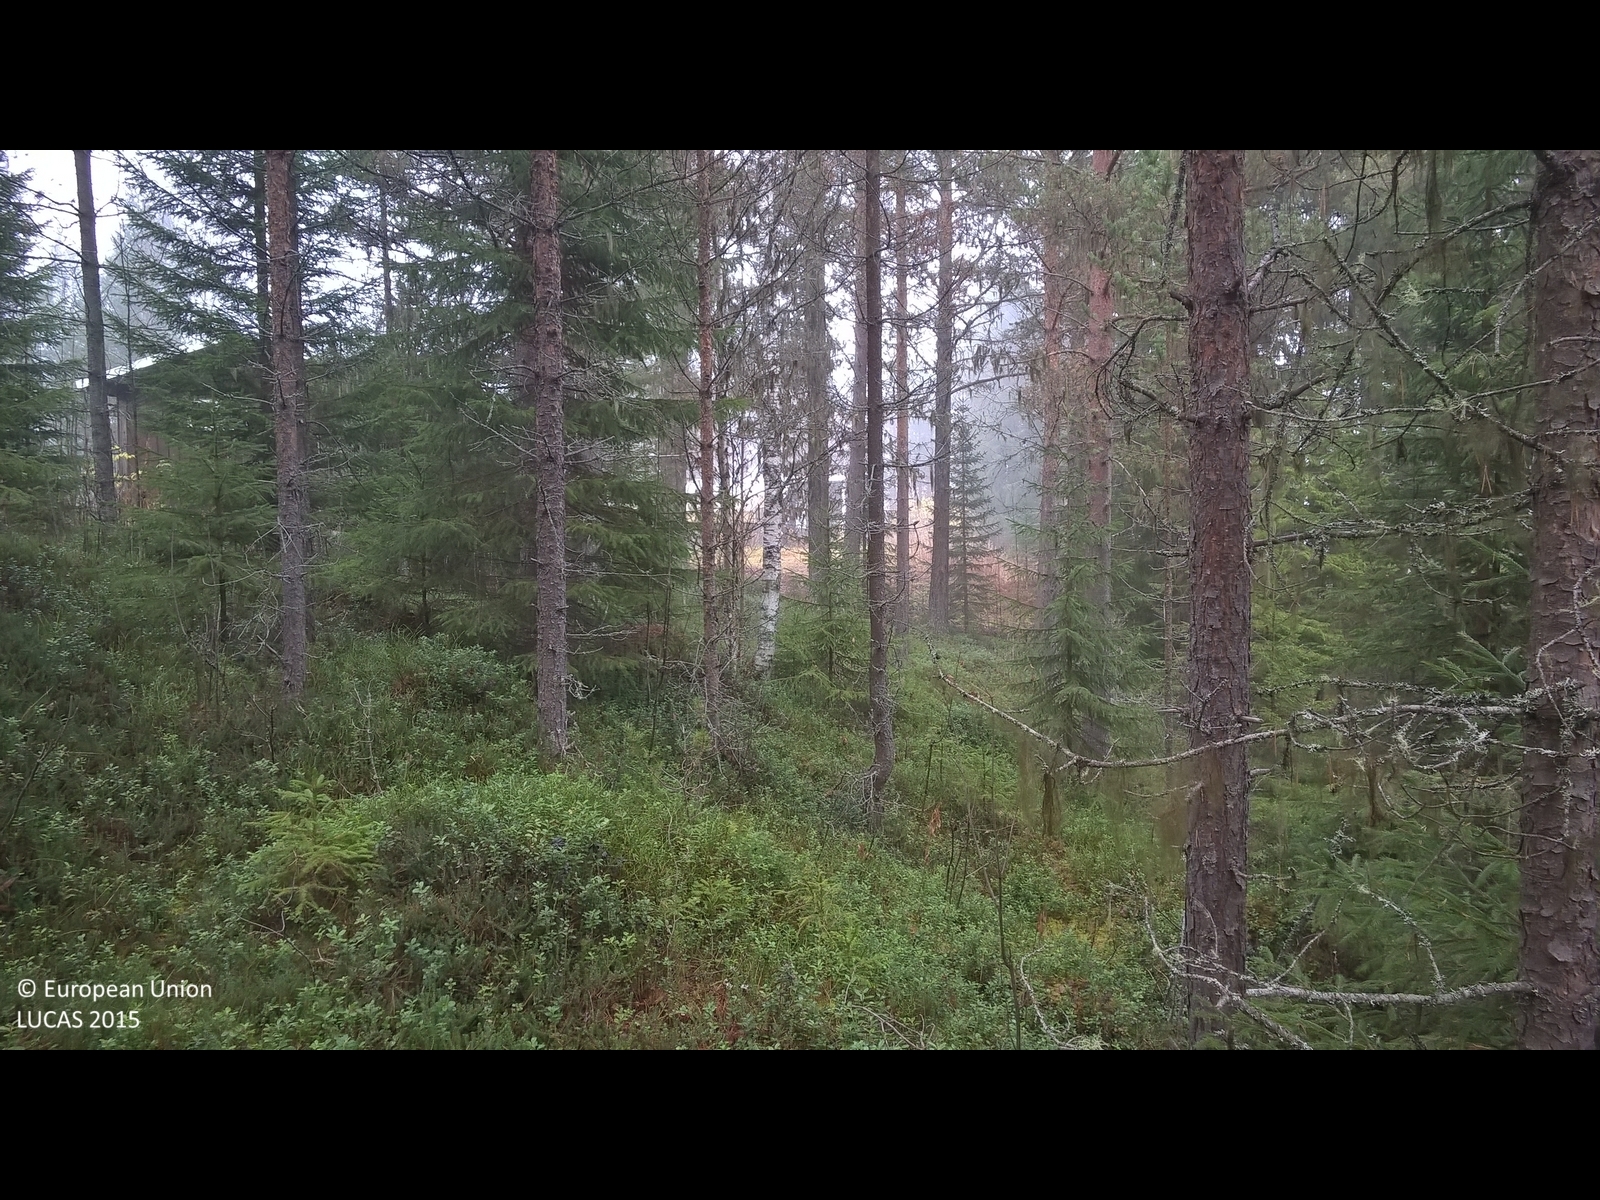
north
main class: Woodland
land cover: Pine dominated coniferous woodland
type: boreal forest
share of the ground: > 75 %
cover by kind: coniferous forest trees 65 %, lichens and mosses 20 %, broadleaved forest trees 10 %, herbaceous plants 5 %
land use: Forestry
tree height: > 5 m
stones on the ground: < 10 %
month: November
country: SE
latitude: 63.2658
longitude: 13.9060
